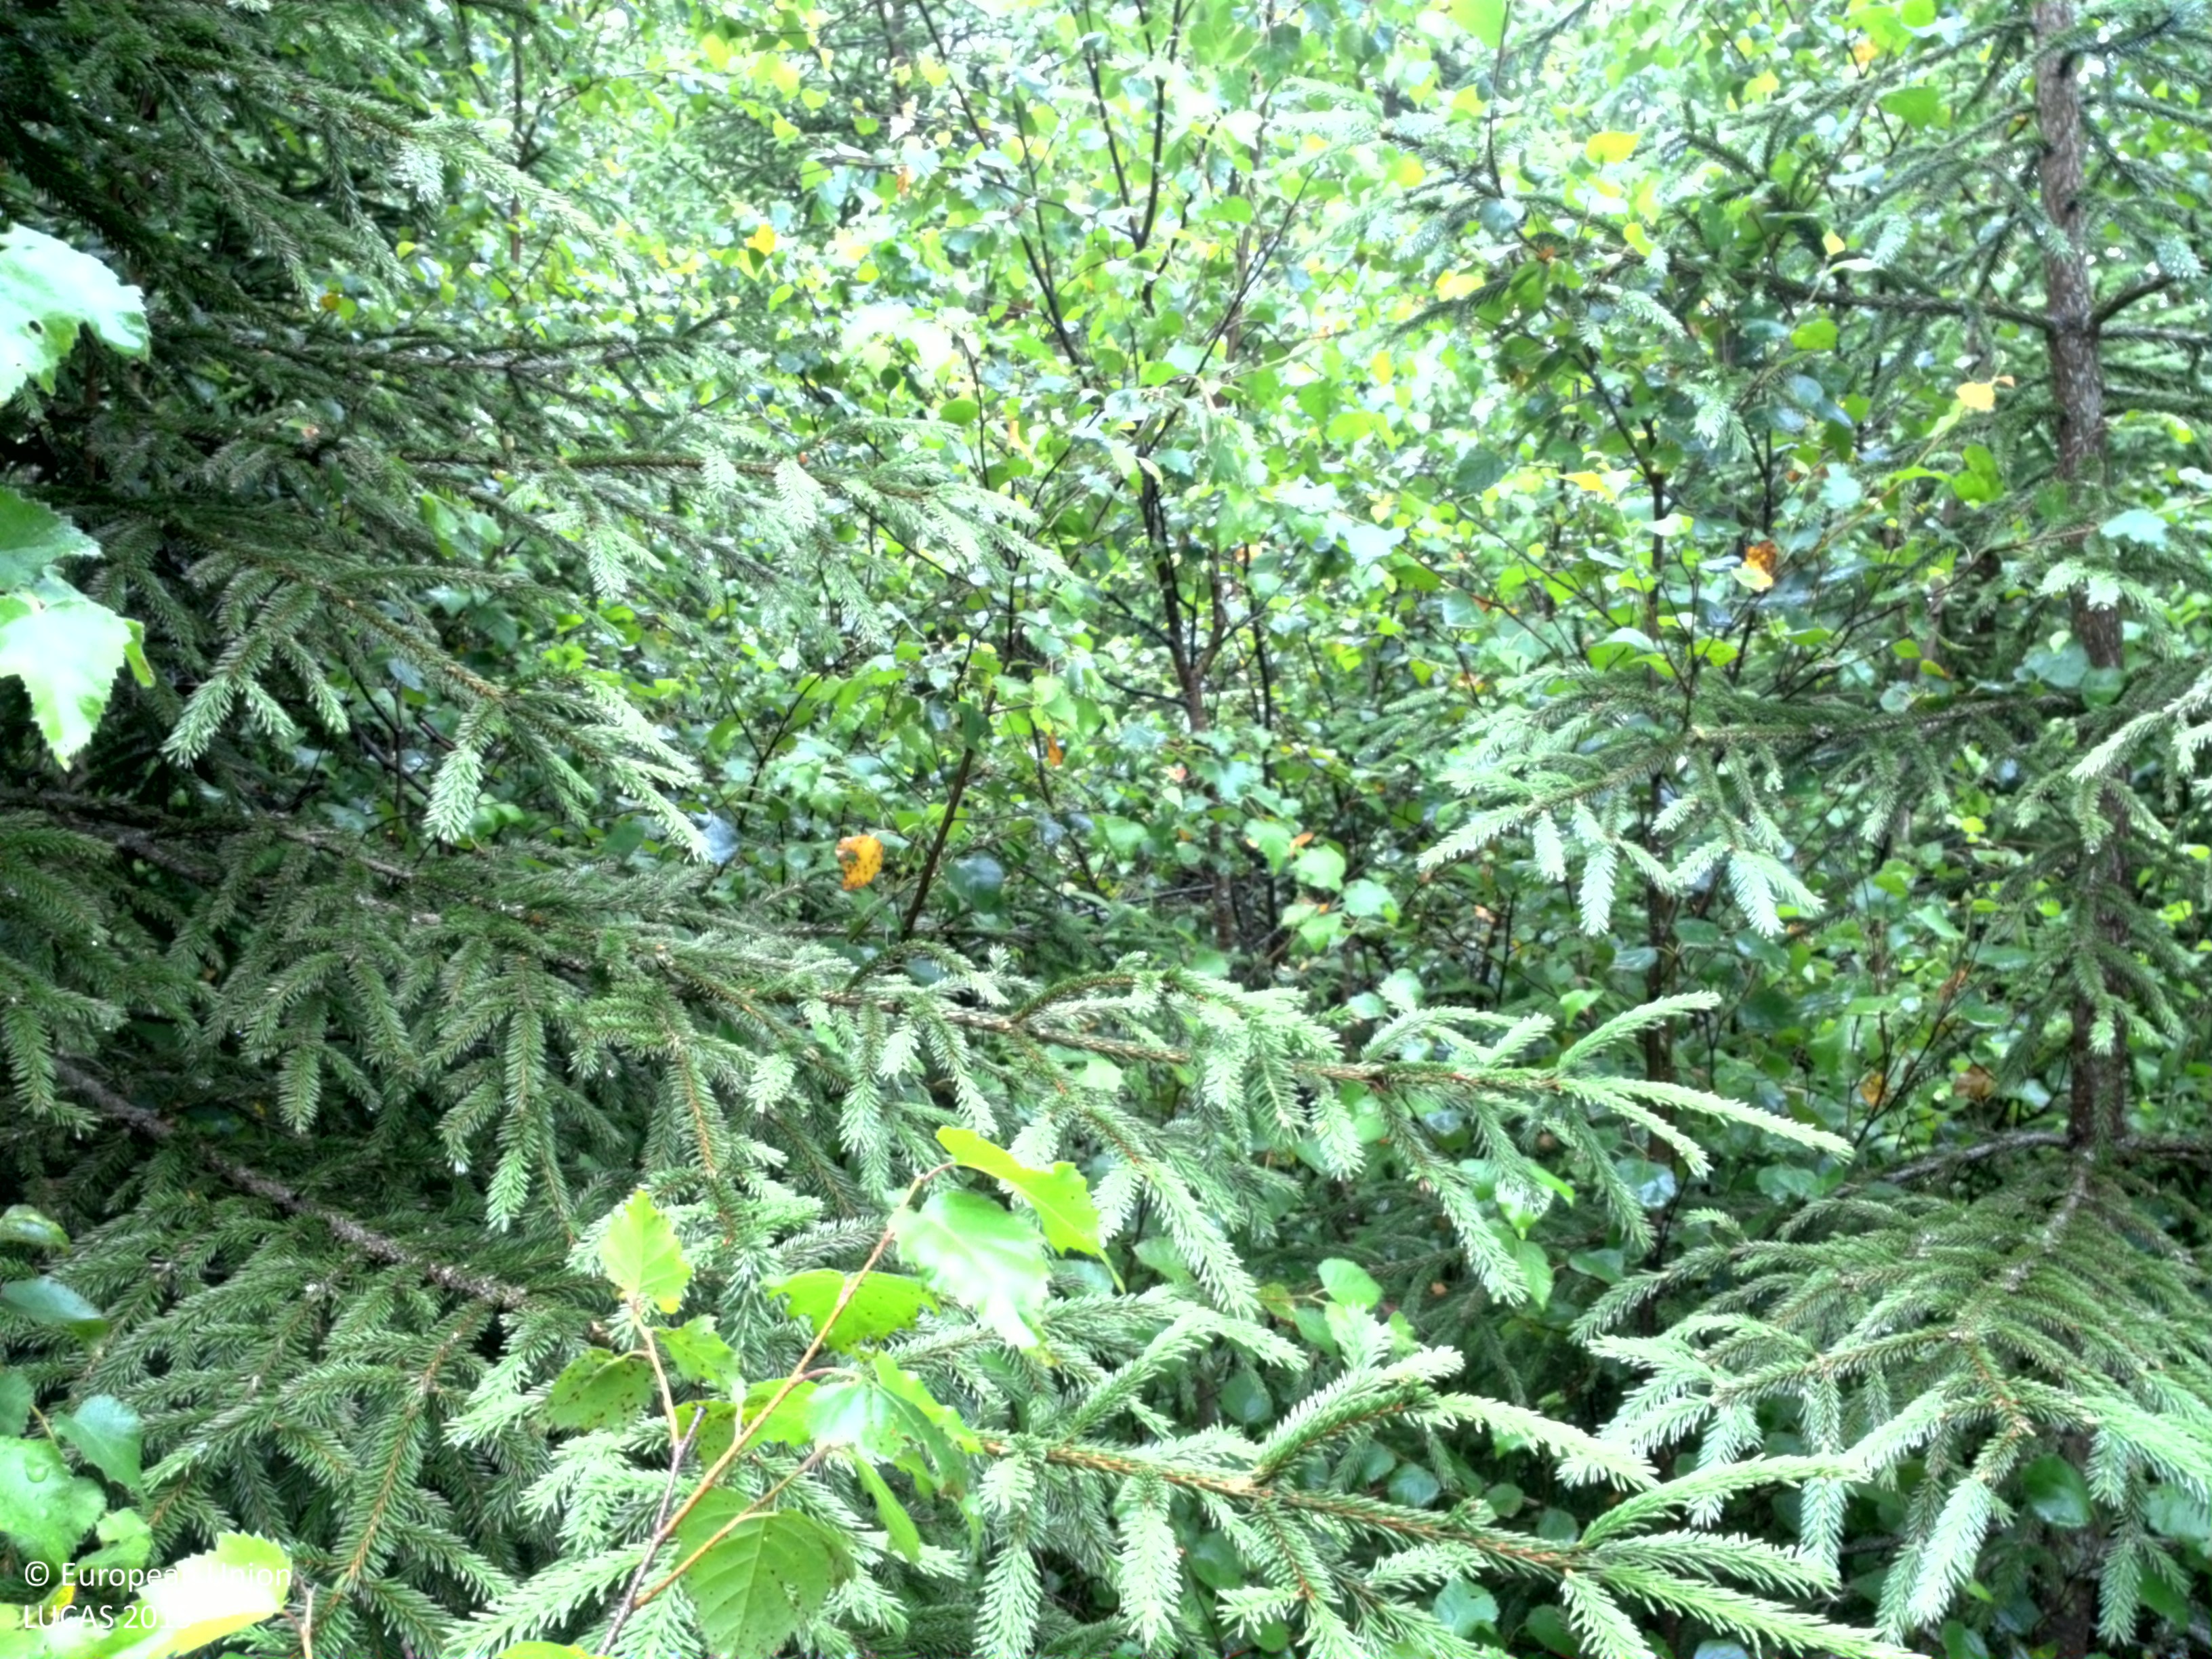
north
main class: Woodland
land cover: Spruce dominated mixed woodland
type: boreal forest
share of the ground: > 75 %
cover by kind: coniferous forest trees 50 %, broadleaved forest trees 40 %, herbaceous plants 5 %, lichens and mosses 5 %
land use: Forestry
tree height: > 5 m
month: July
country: SE
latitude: 59.8592
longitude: 18.3713
